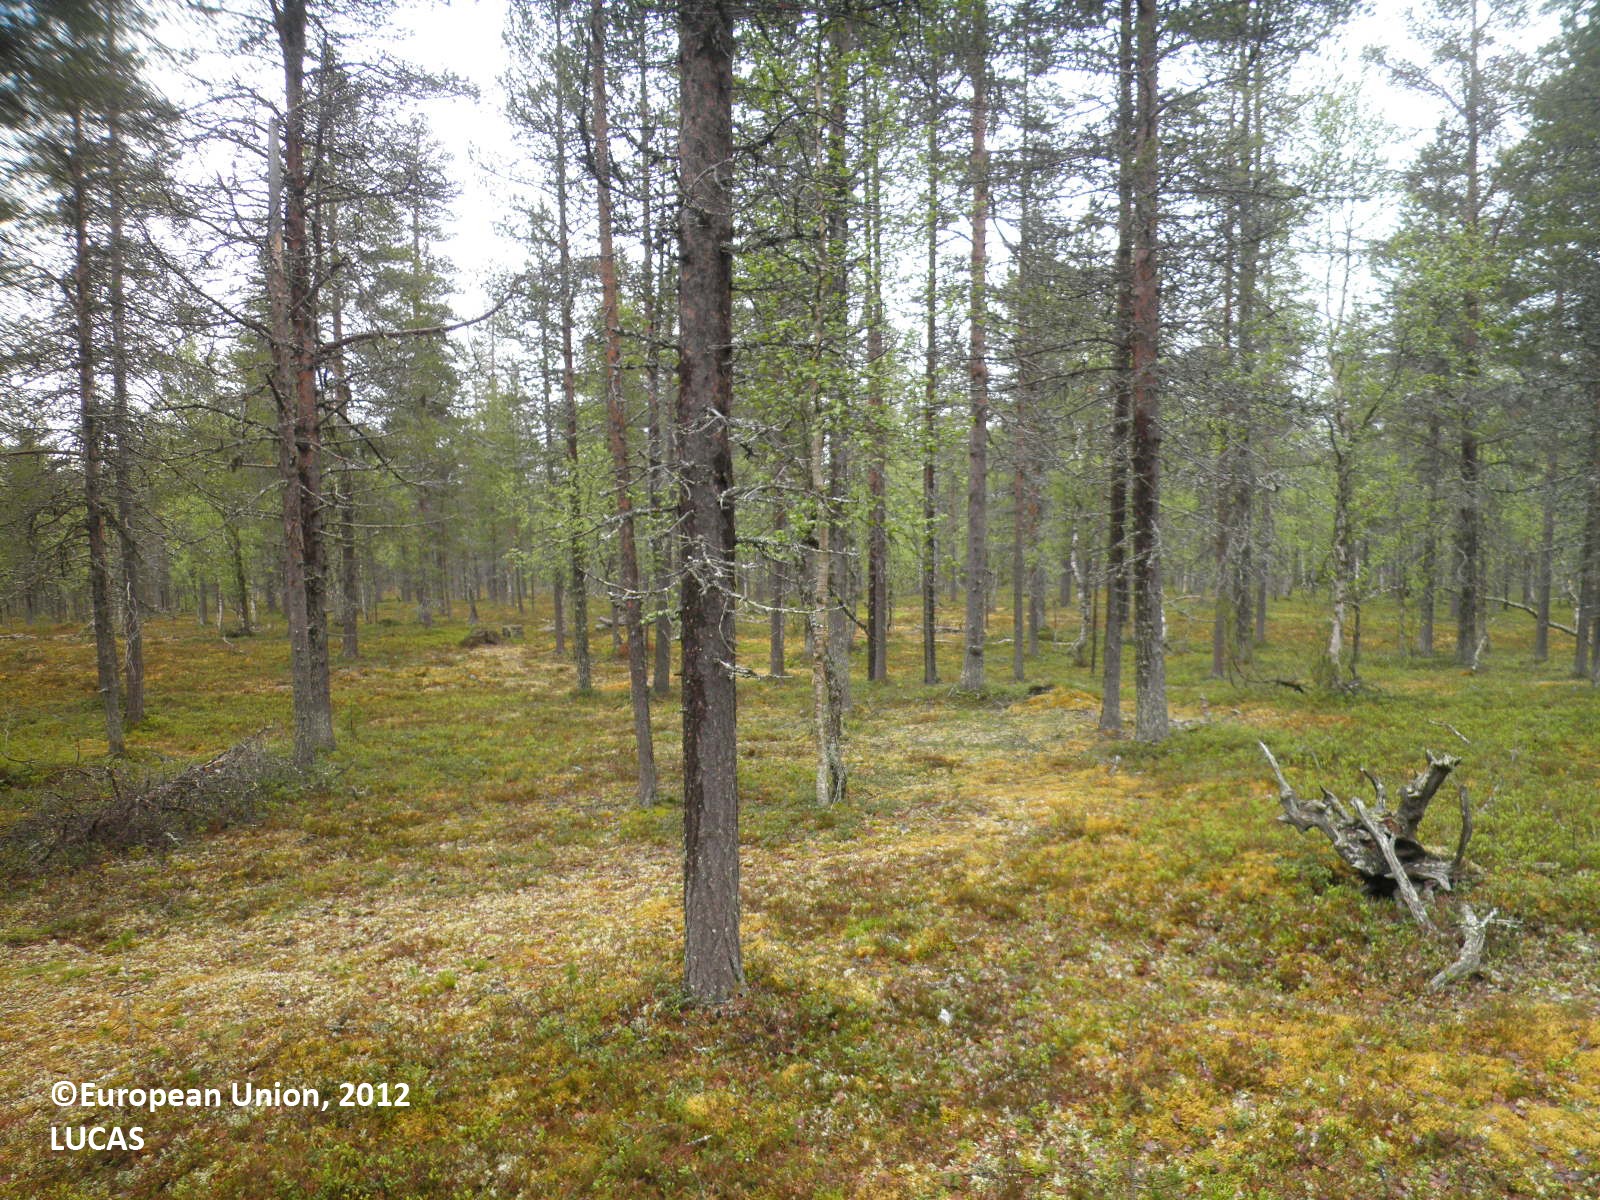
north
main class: Woodland
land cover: Pine dominated coniferous woodland
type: boreal forest
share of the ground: 25 - 50 %
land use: Forestry
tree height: > 5 m
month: June
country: FI
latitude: 68.1420
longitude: 25.6135
